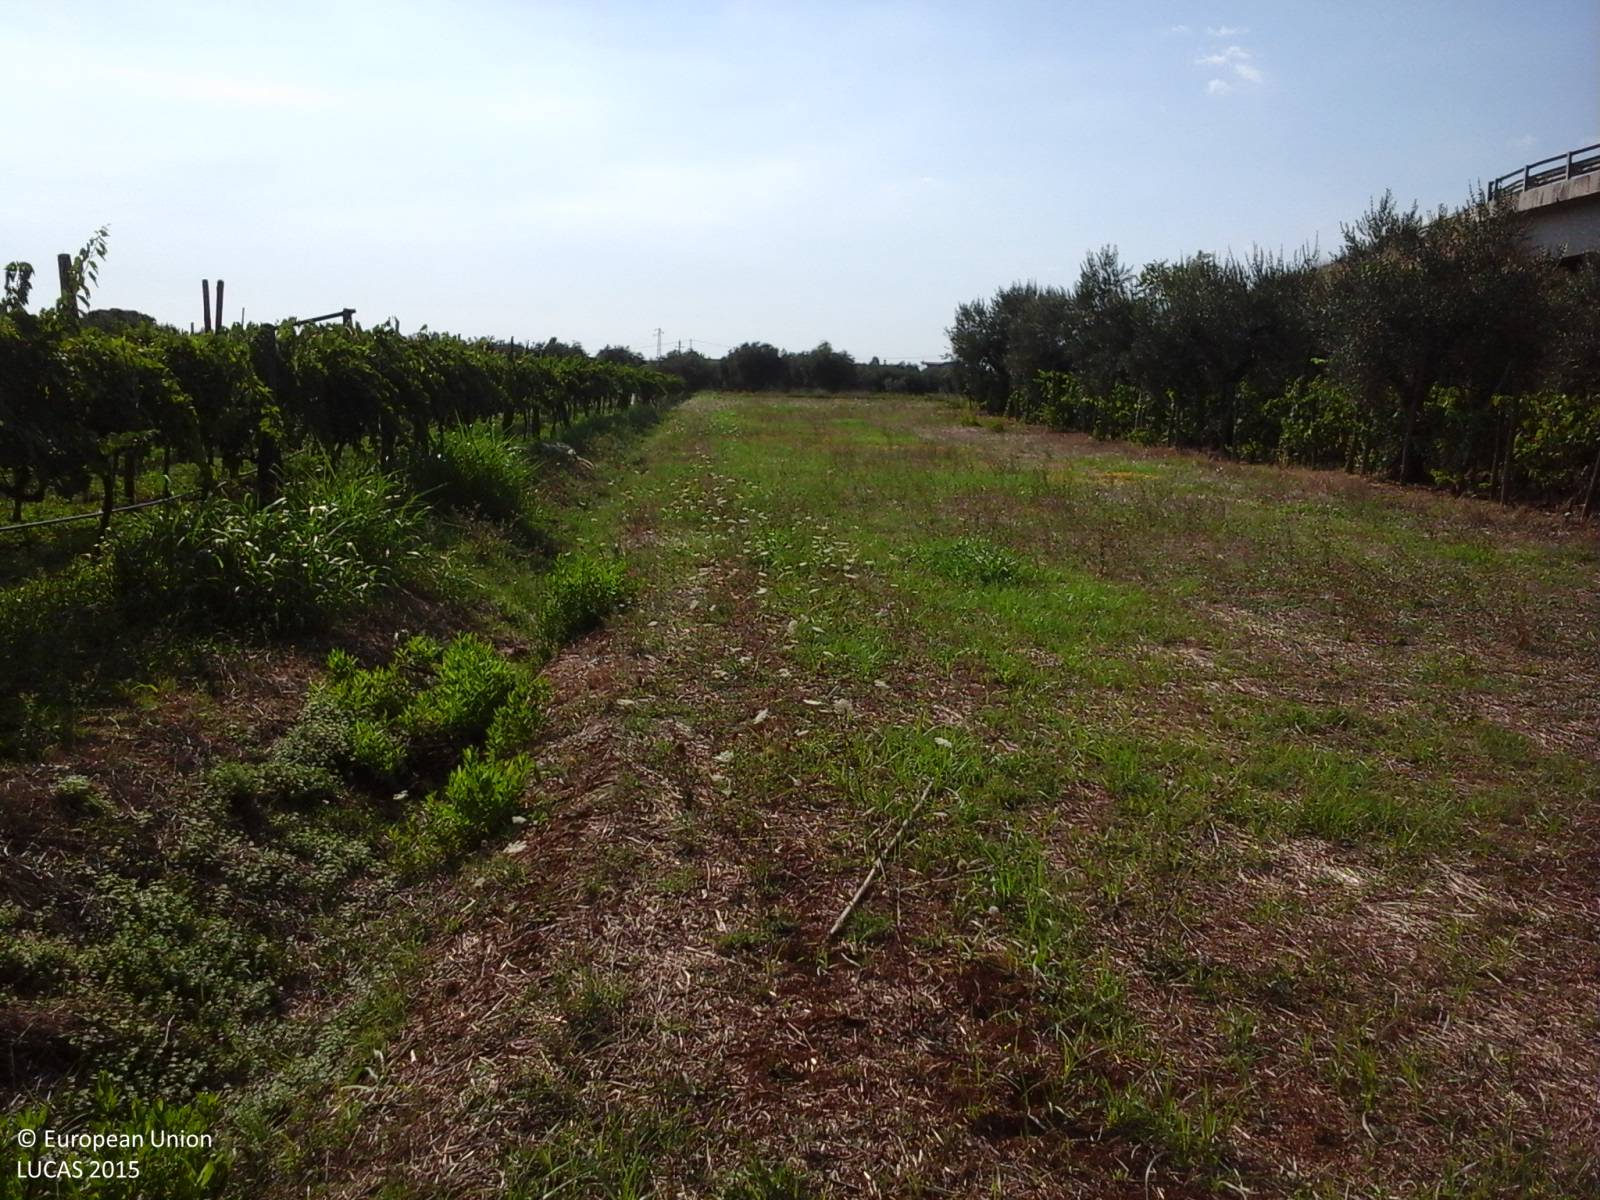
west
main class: Grassland
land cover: Spontaneously vegetated surfaces
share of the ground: > 75 %
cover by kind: herbaceous plants 100 %
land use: Agriculture (excluding fallow land and kitchen gardens)
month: August
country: IT
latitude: 41.3918
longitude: 13.2043
